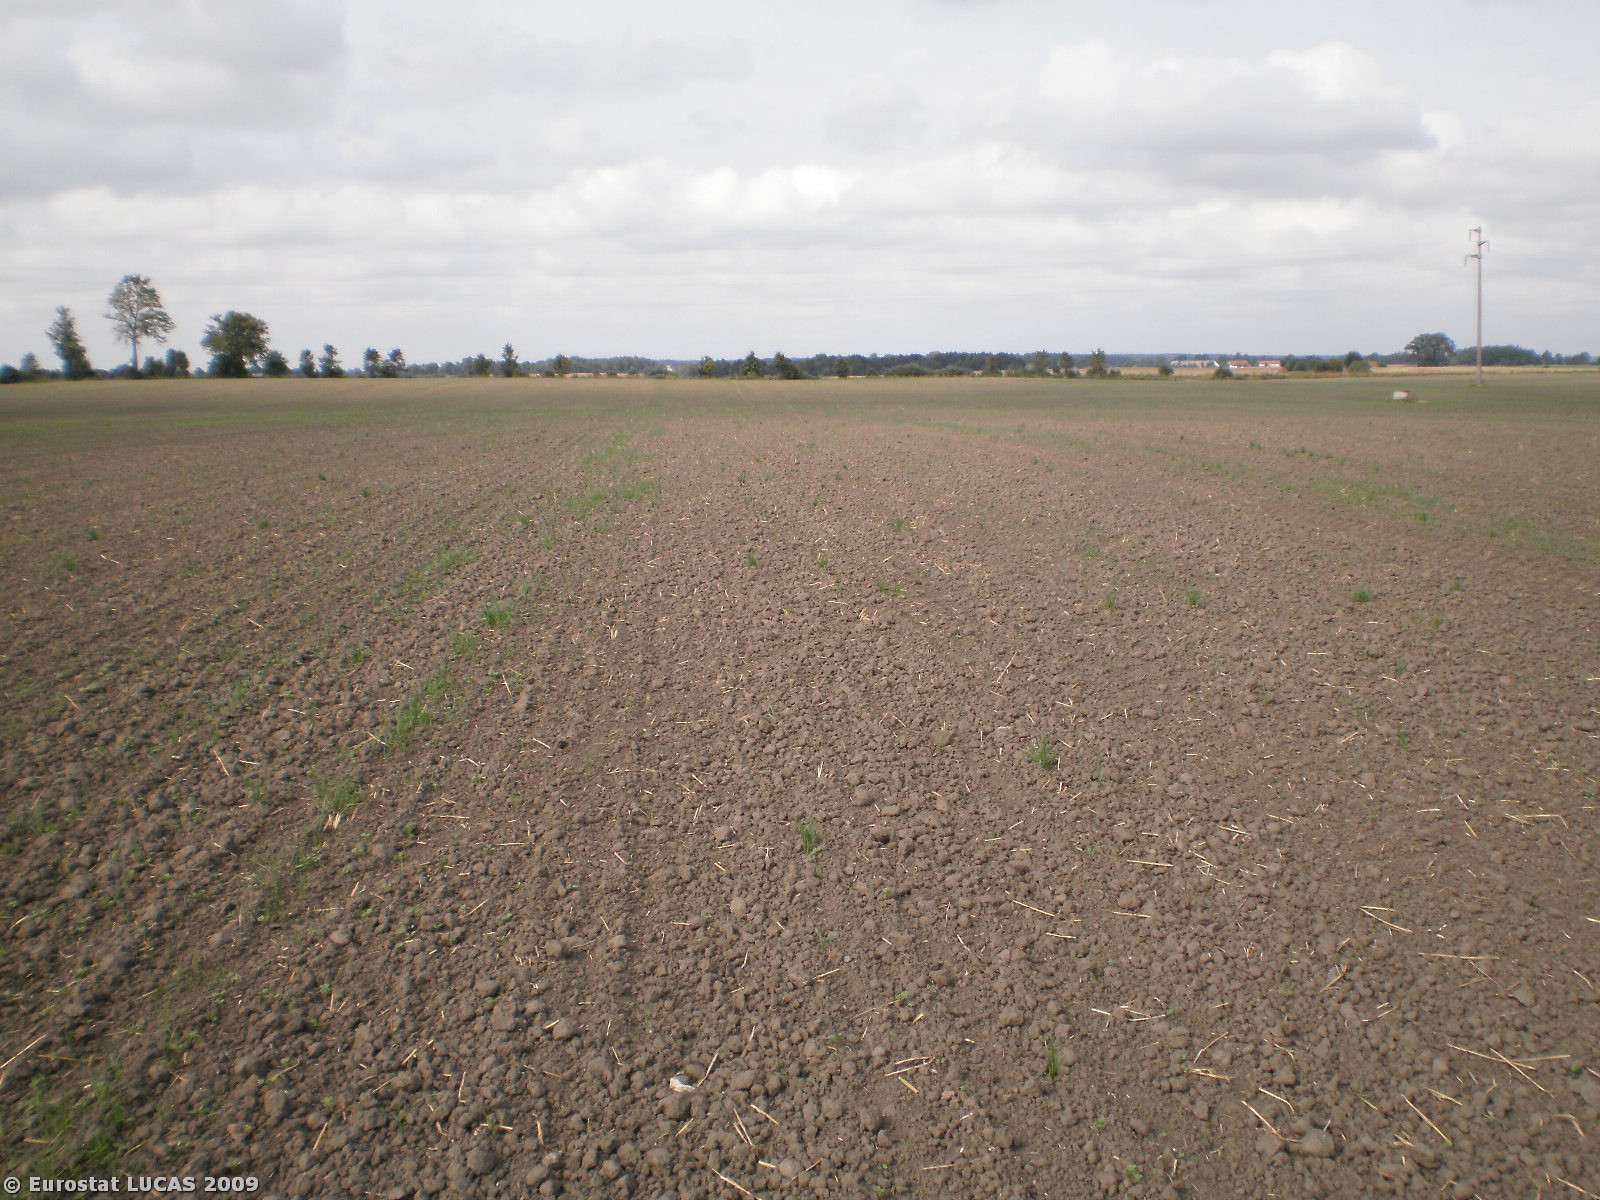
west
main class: Cropland
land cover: Common wheat
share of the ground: < 10 %
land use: Agriculture (excluding fallow land and kitchen gardens)
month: August
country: PL
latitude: 54.2192
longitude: 21.2565
